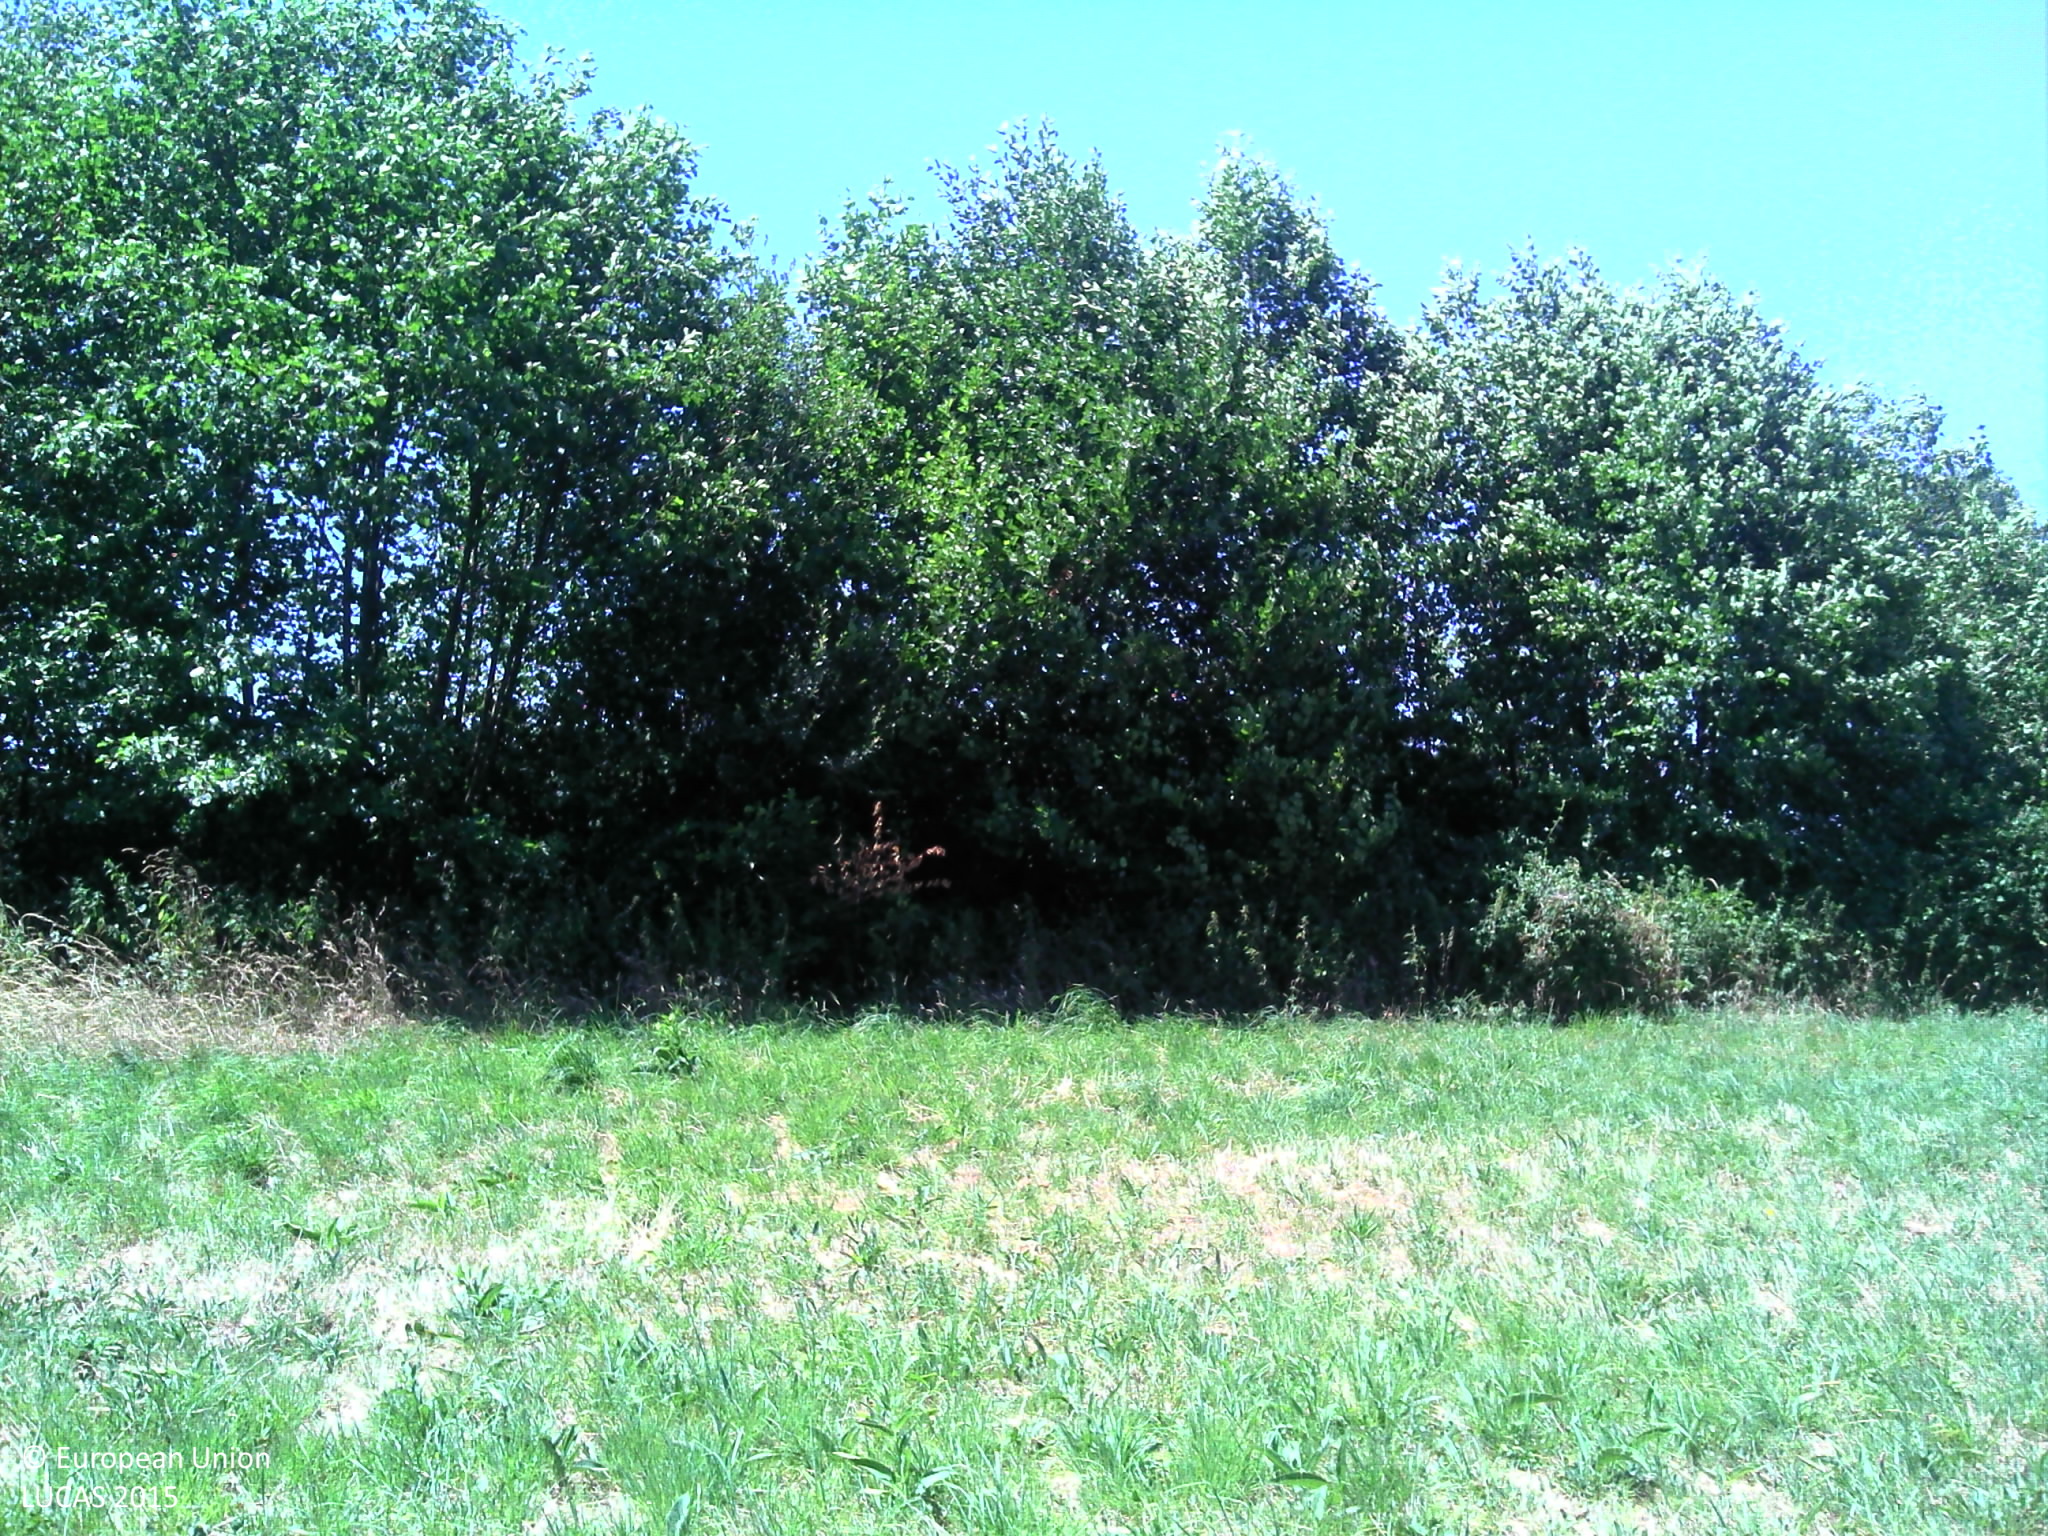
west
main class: Grassland
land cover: Grassland without tree/shrub cover
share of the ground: > 75 %
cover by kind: herbaceous plants 95 %, shrubs 5 %
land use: Agriculture (excluding fallow land and kitchen gardens)
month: July
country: FR
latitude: 47.6829
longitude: 0.2644
